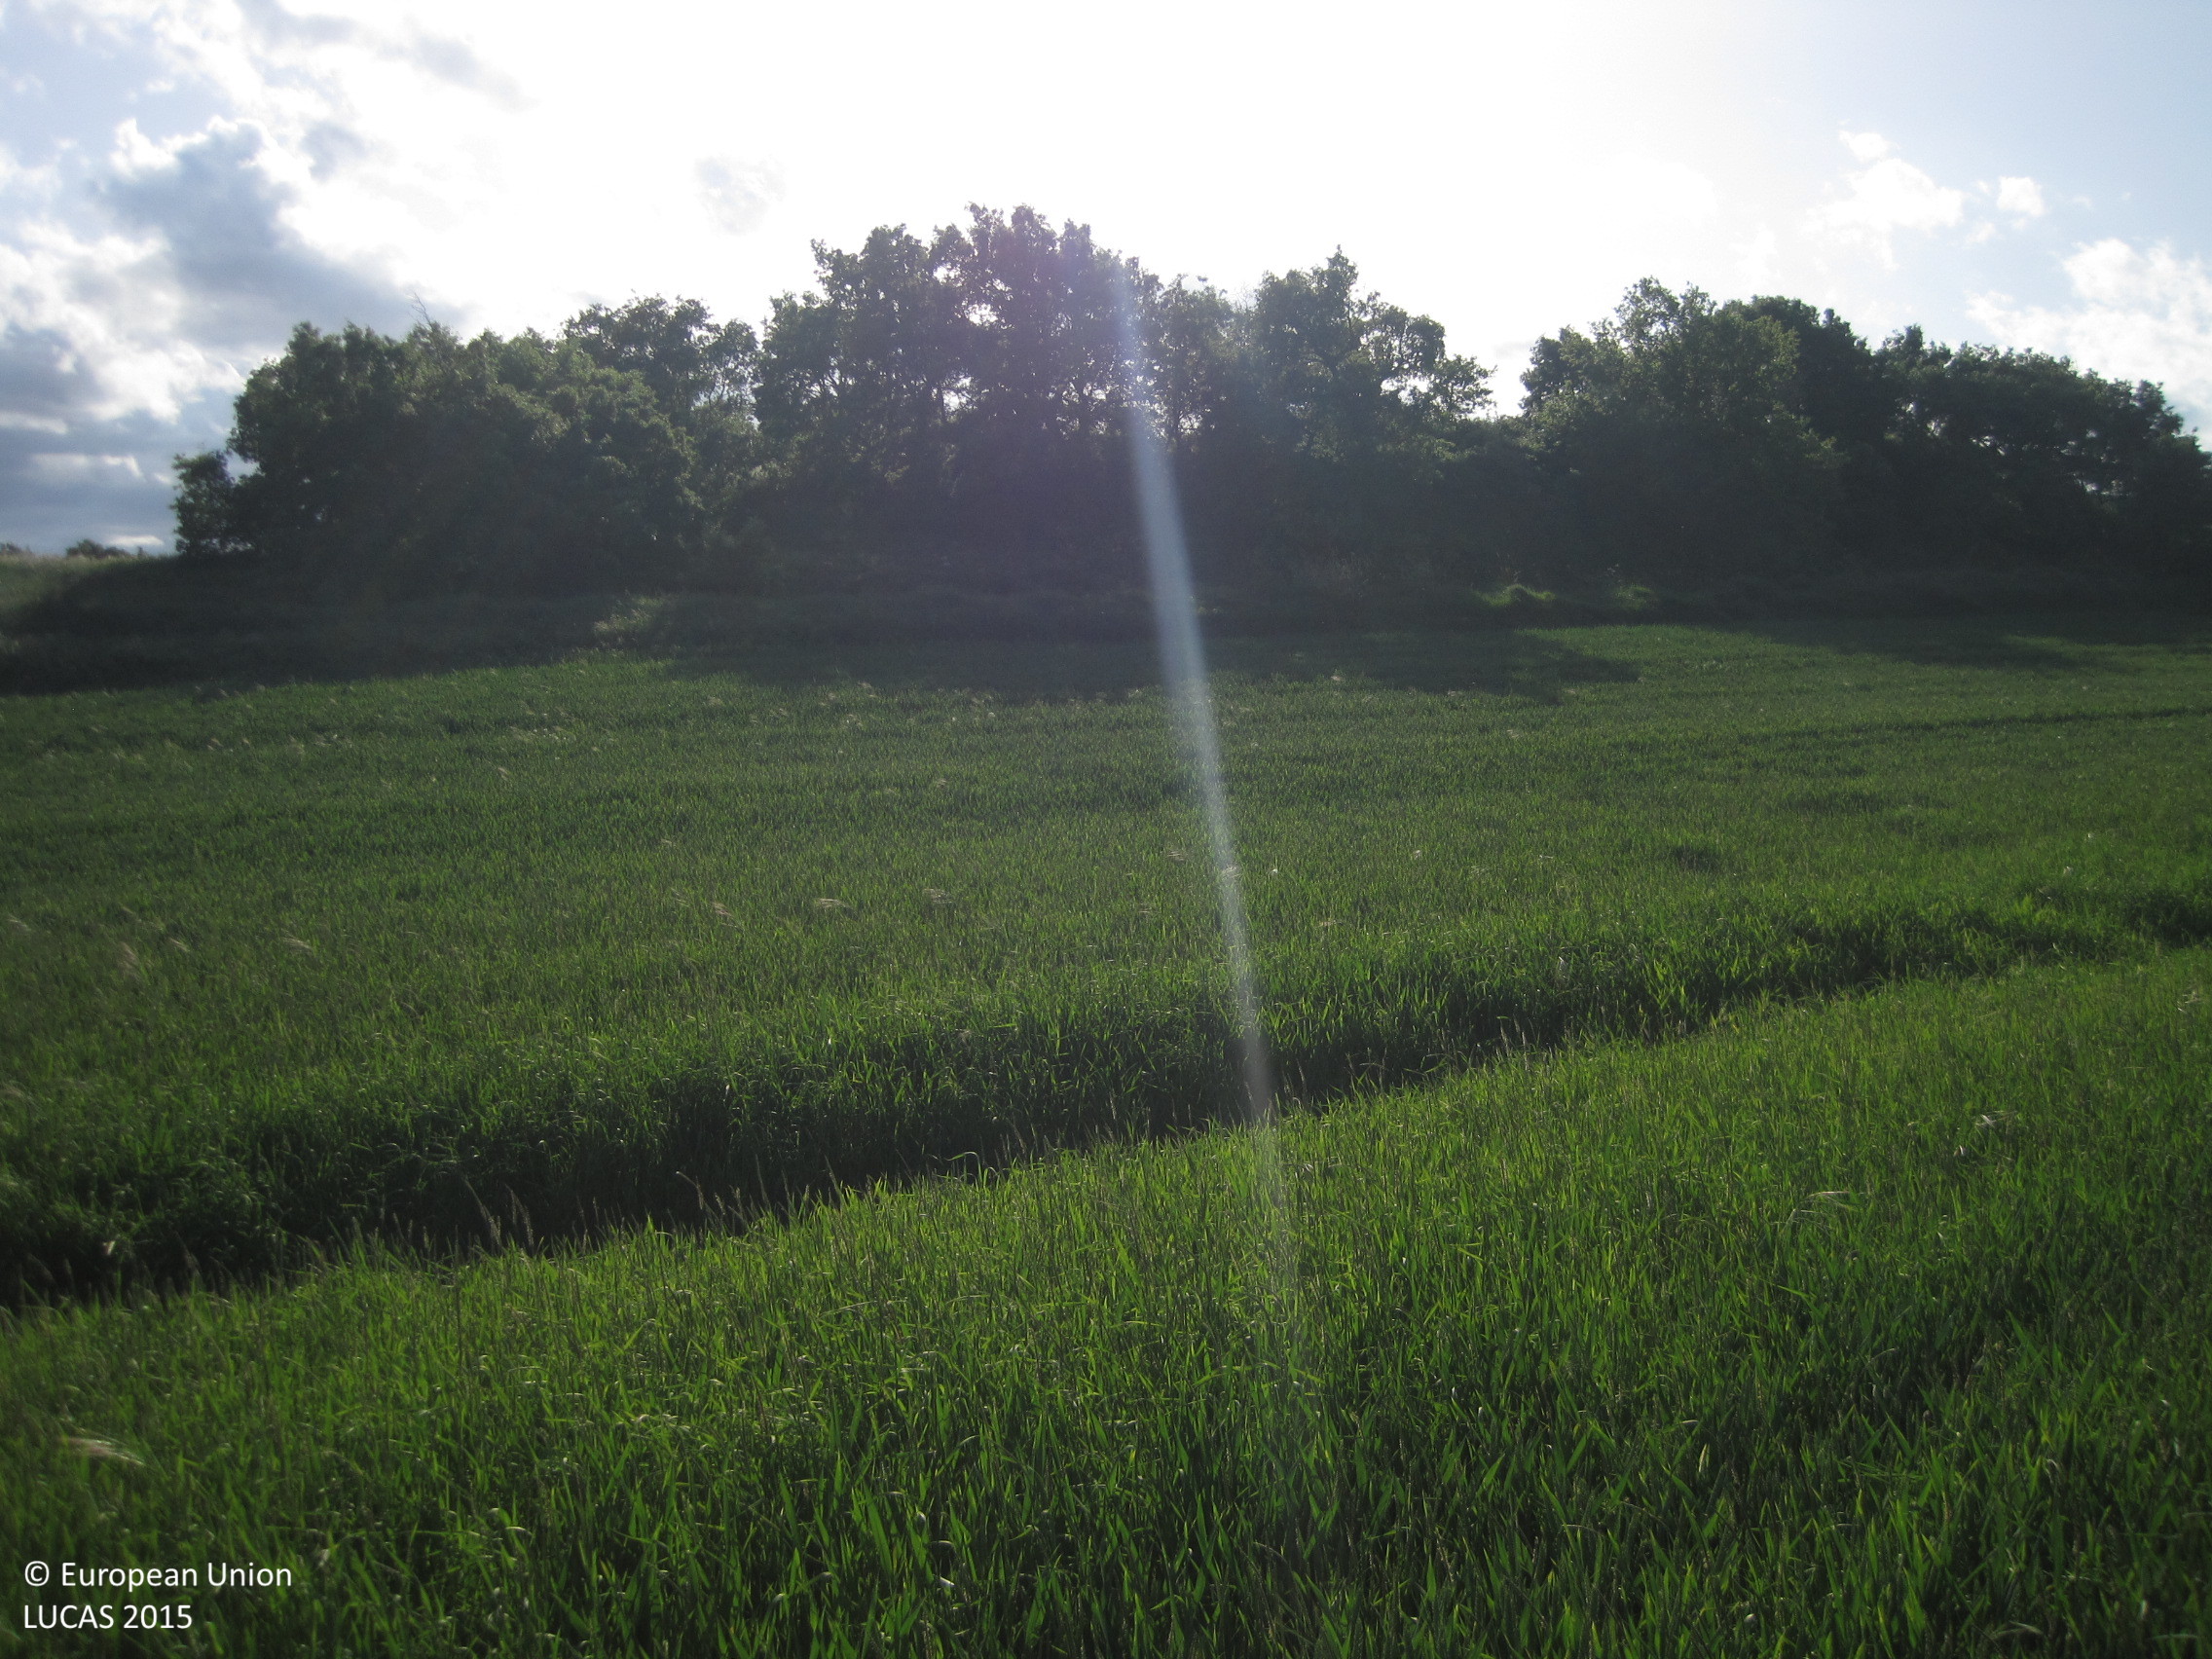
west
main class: Cropland
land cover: Common wheat
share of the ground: > 75 %
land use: Agriculture (excluding fallow land and kitchen gardens)
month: May
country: ES
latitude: 42.6316
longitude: -1.6833
